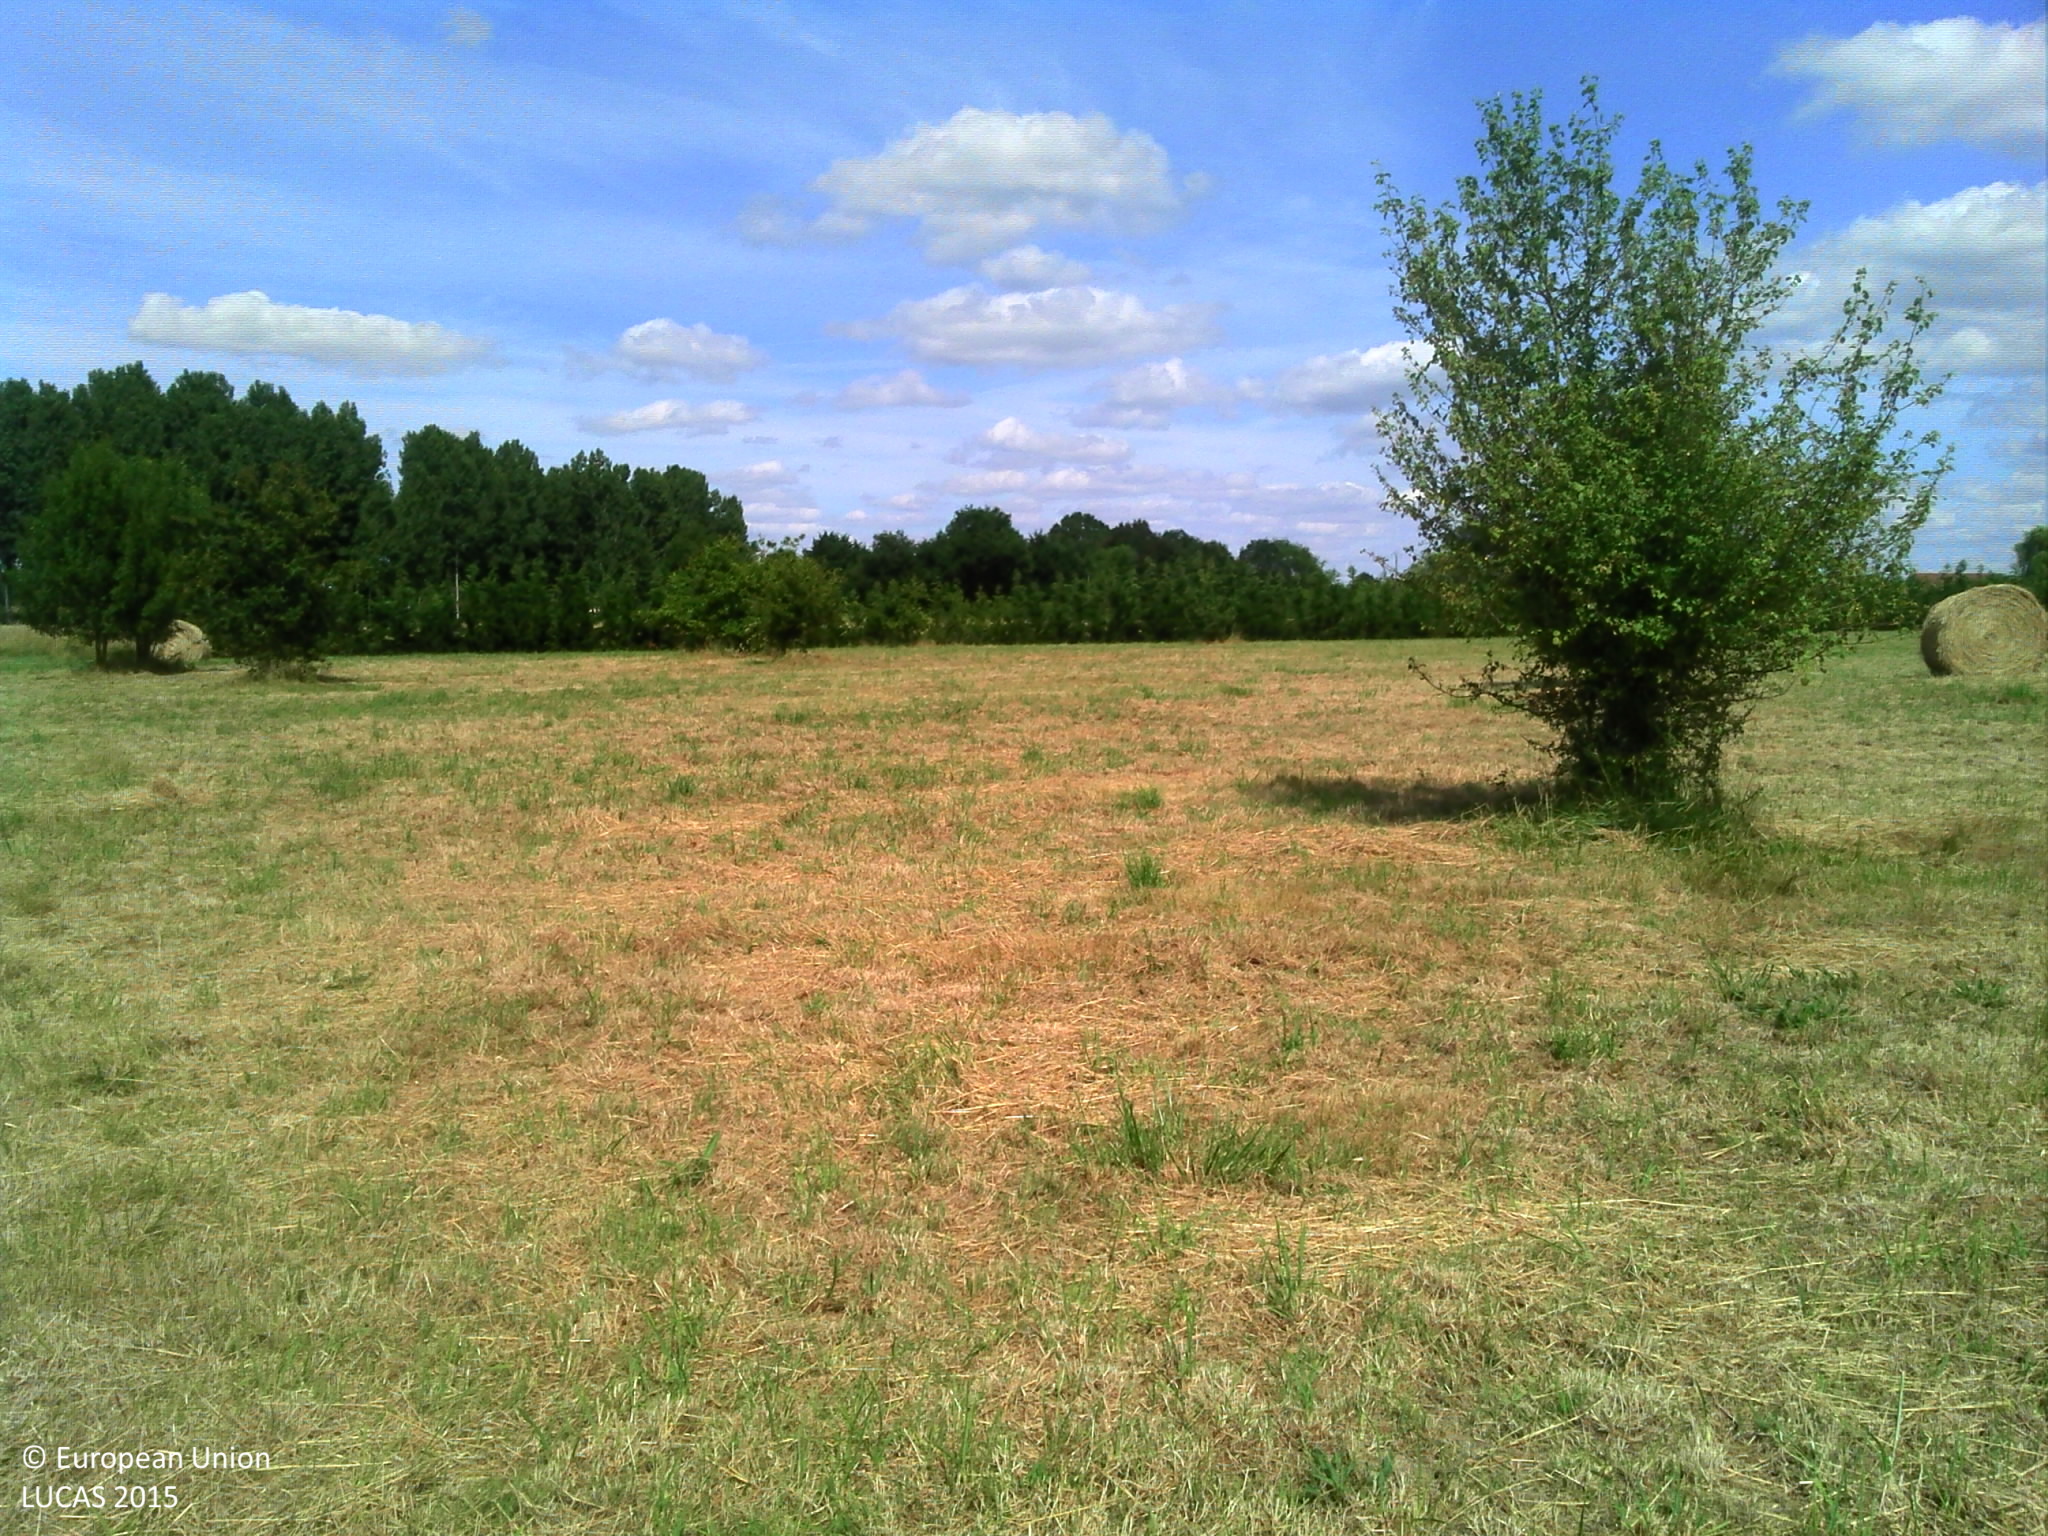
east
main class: Grassland
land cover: Grassland without tree/shrub cover
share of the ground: > 75 %
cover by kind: herbaceous plants 100 %
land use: Agriculture (excluding fallow land and kitchen gardens)
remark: Harvested field
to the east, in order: Grassland without tree/shrub cover; Conifer hedges; Grass margins; Fences; Grass margins; Ditches and canals; Grass margins; Paved roads, cycling and walking lanes; Grass margins; Ditches and canals; Grass margins; Common wheat; Fences; Abandoned hedges; Grassland without tree/shrub cover
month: June
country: FR
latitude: 47.4869
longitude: 0.3016
